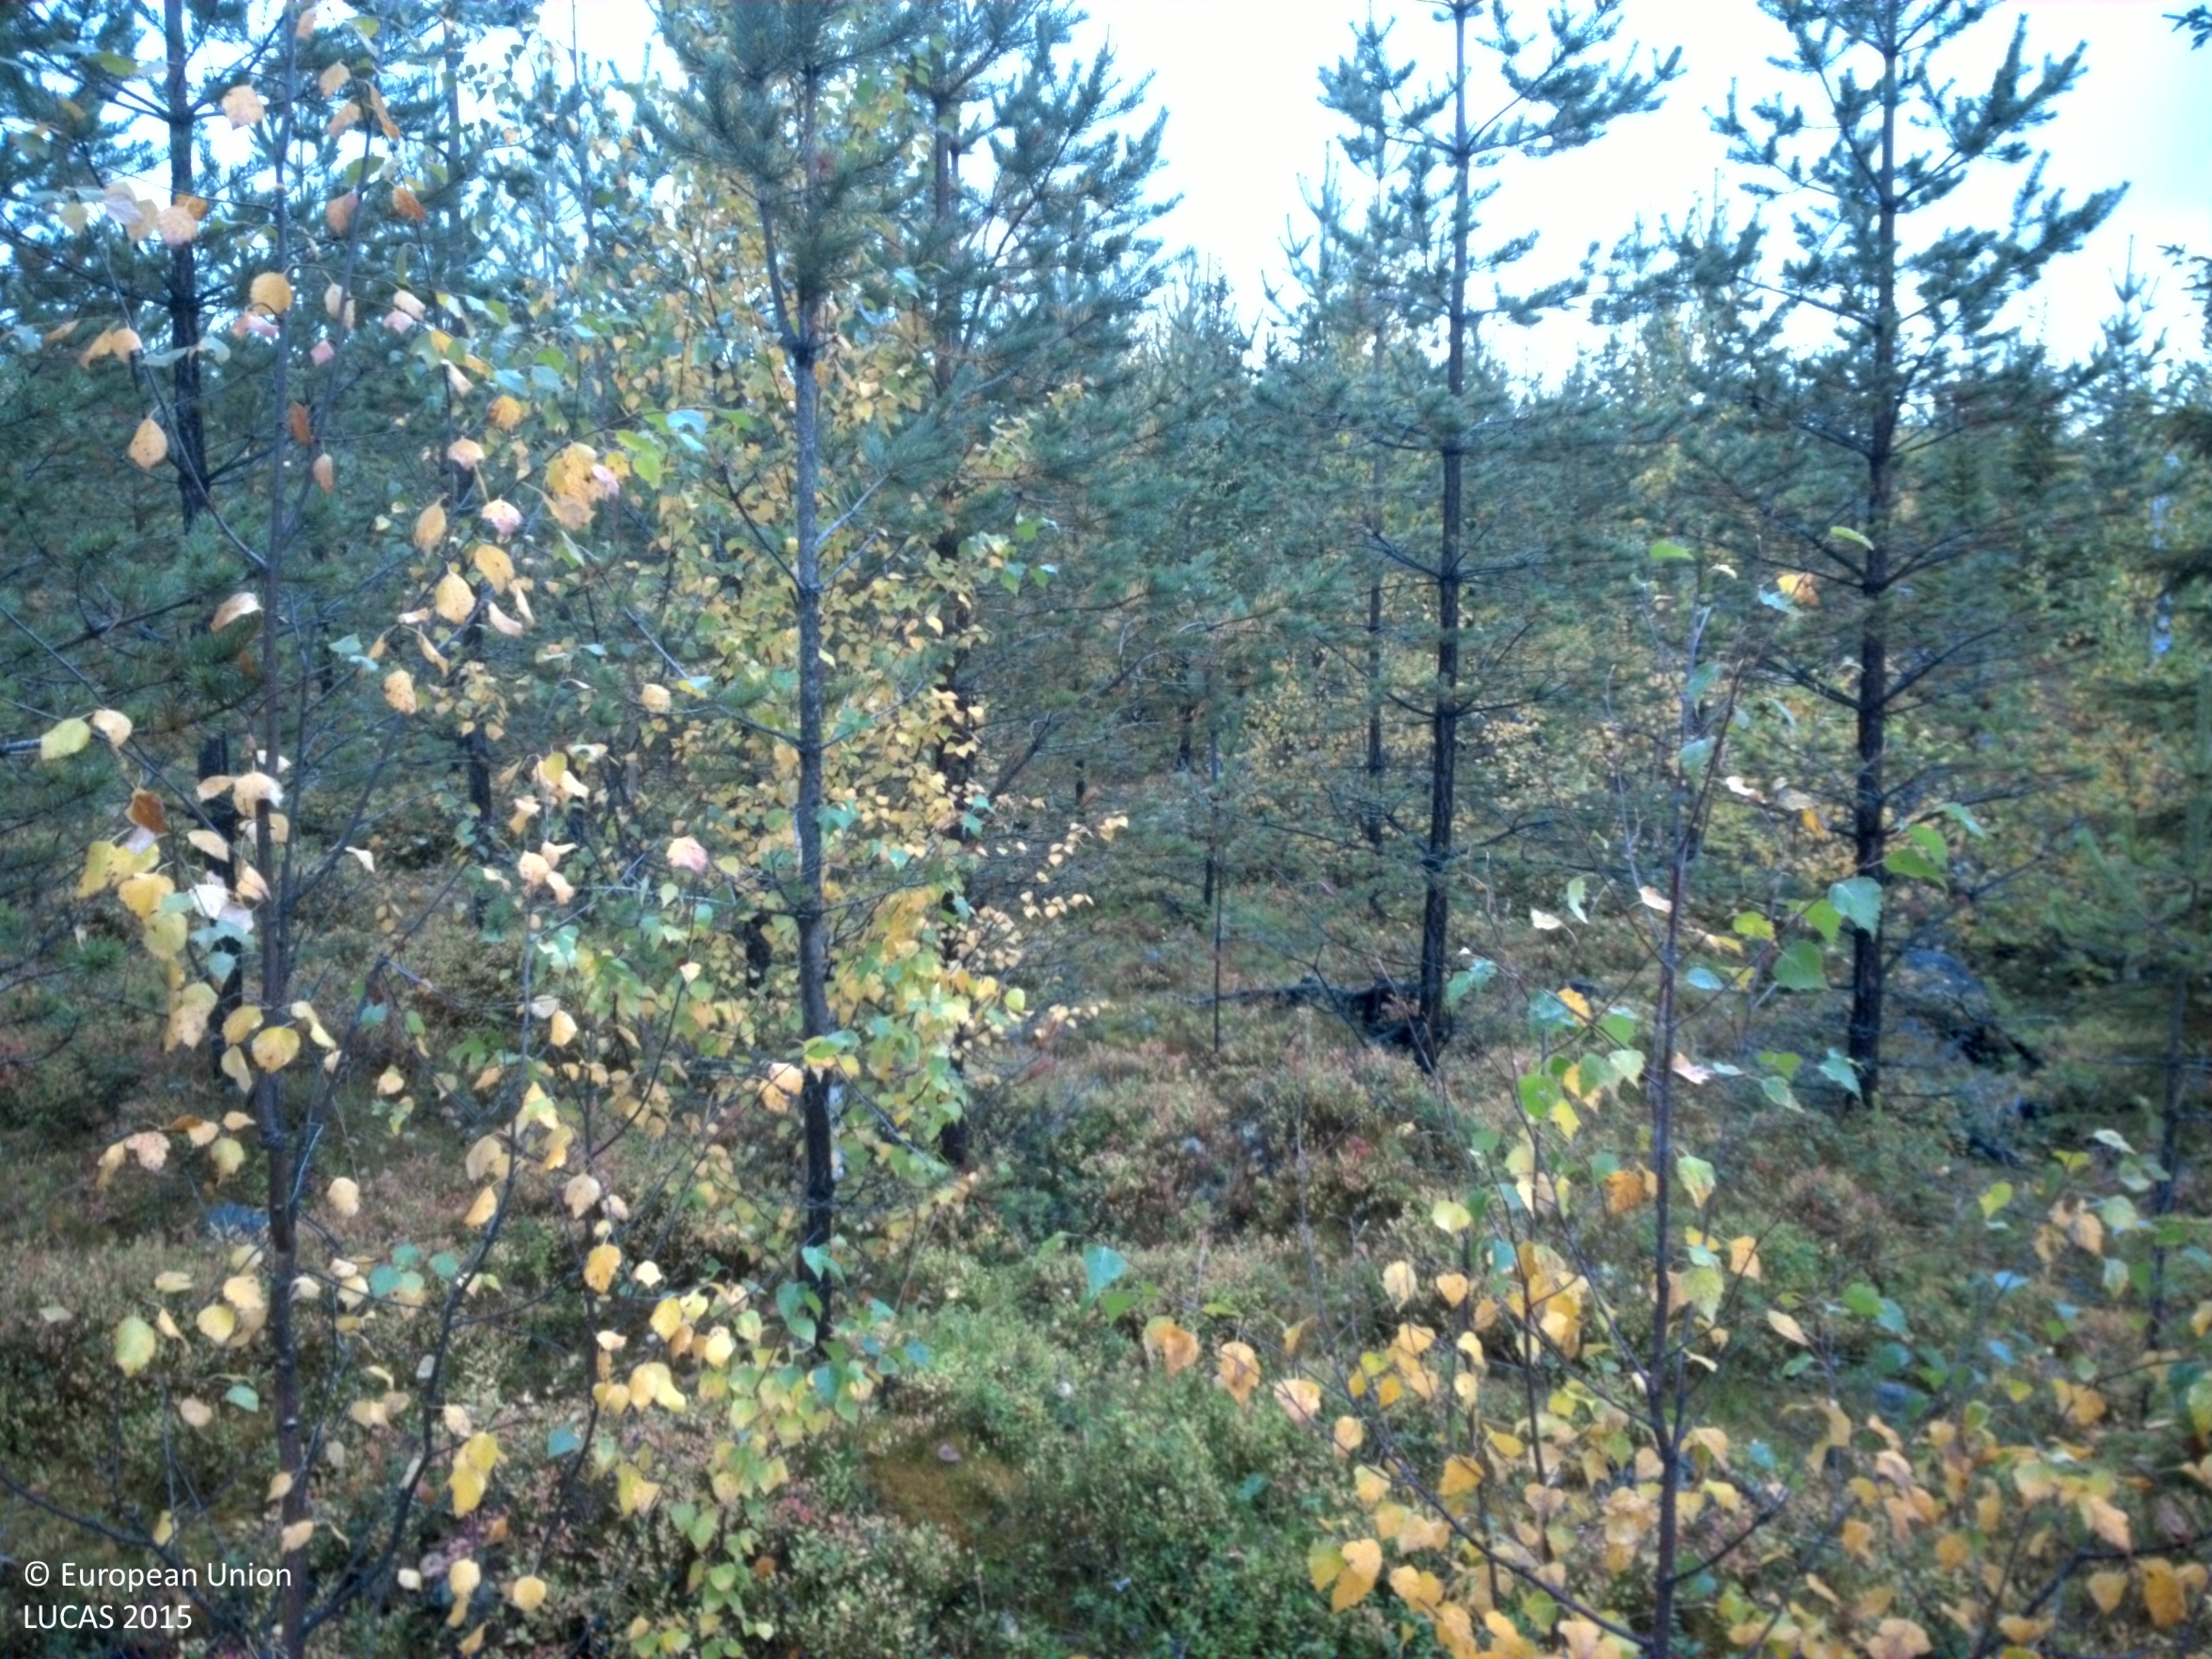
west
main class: Woodland
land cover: Pine dominated mixed woodland
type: boreal forest
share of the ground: 25 - 50 %
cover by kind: coniferous forest trees 30 %, shrubs 30 %, herbaceous plants 15 %, lichens and mosses 15 %, broadleaved forest trees 10 %
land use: Forestry
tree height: > 5 m
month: September
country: SE
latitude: 65.0735
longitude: 17.5121
